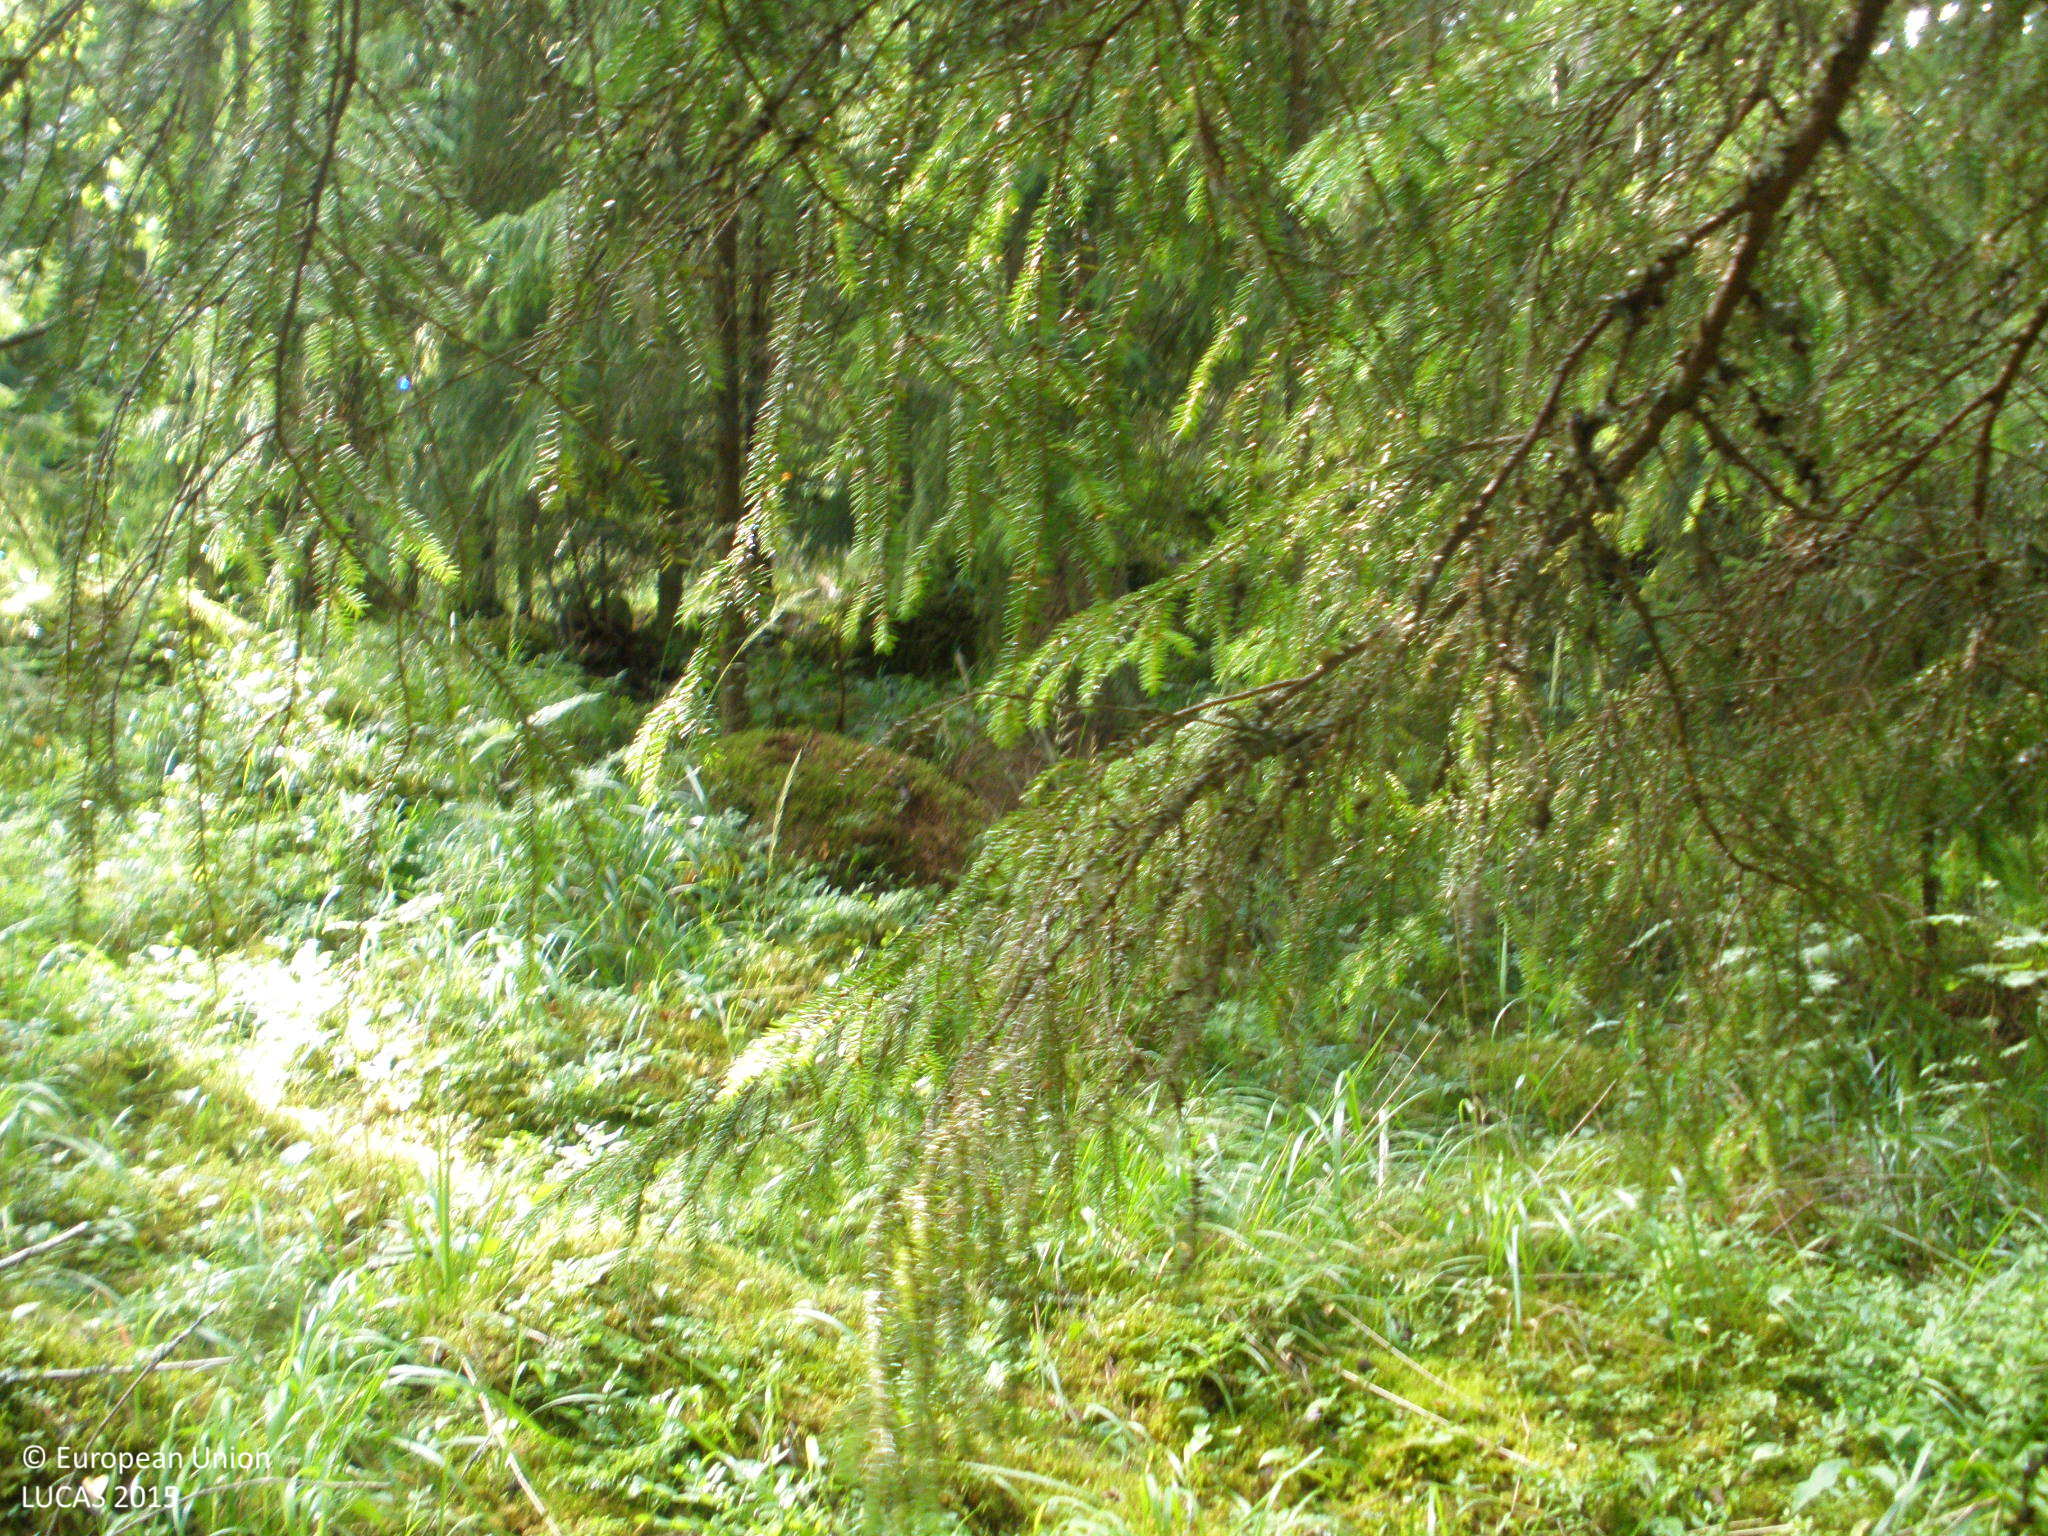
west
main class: Woodland
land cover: Spruce dominated coniferous woodland
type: boreal forest
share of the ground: > 75 %
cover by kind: coniferous forest trees 90 %, herbaceous plants 5 %, lichens and mosses 5 %
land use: Forestry
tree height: > 5 m
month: July
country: FI
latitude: 61.2558
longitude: 24.7387
